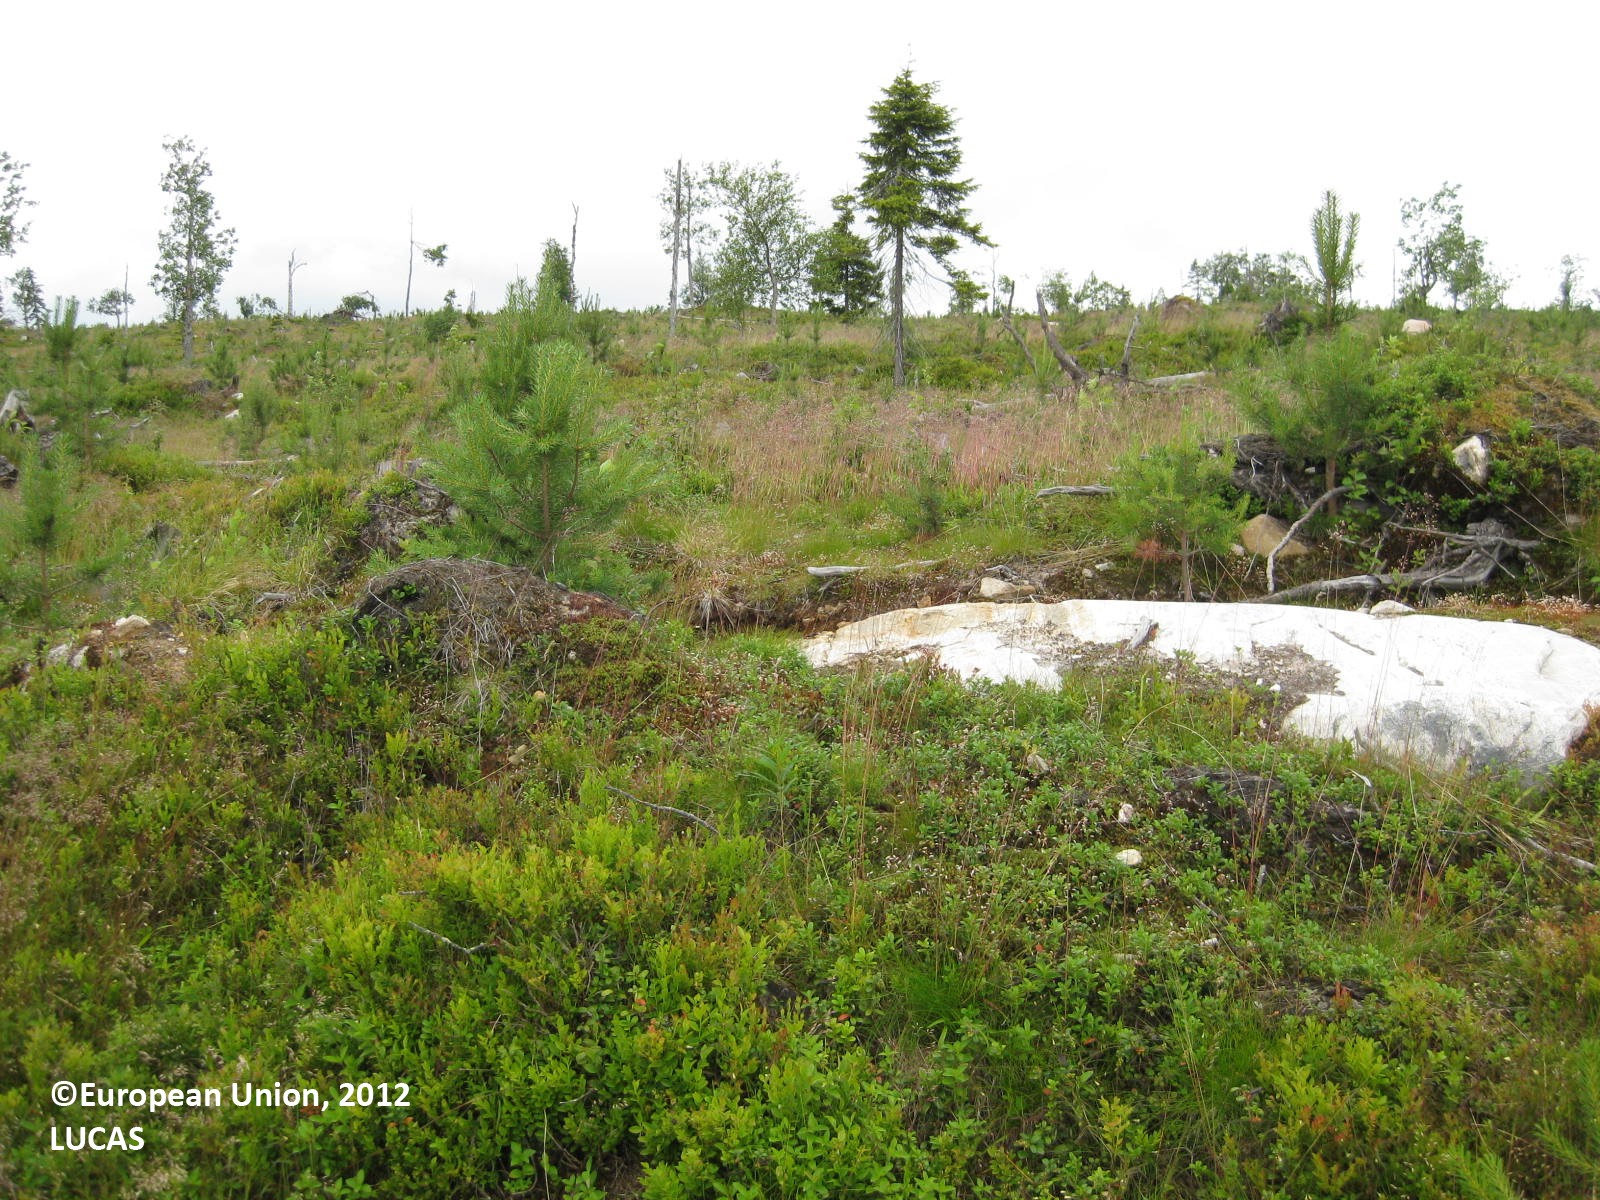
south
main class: Woodland
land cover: Pine dominated coniferous woodland
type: boreal forest
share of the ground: 10 - 25 %
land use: Forestry
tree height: < 5 m
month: July
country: FI
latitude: 65.8107
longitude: 29.3696
